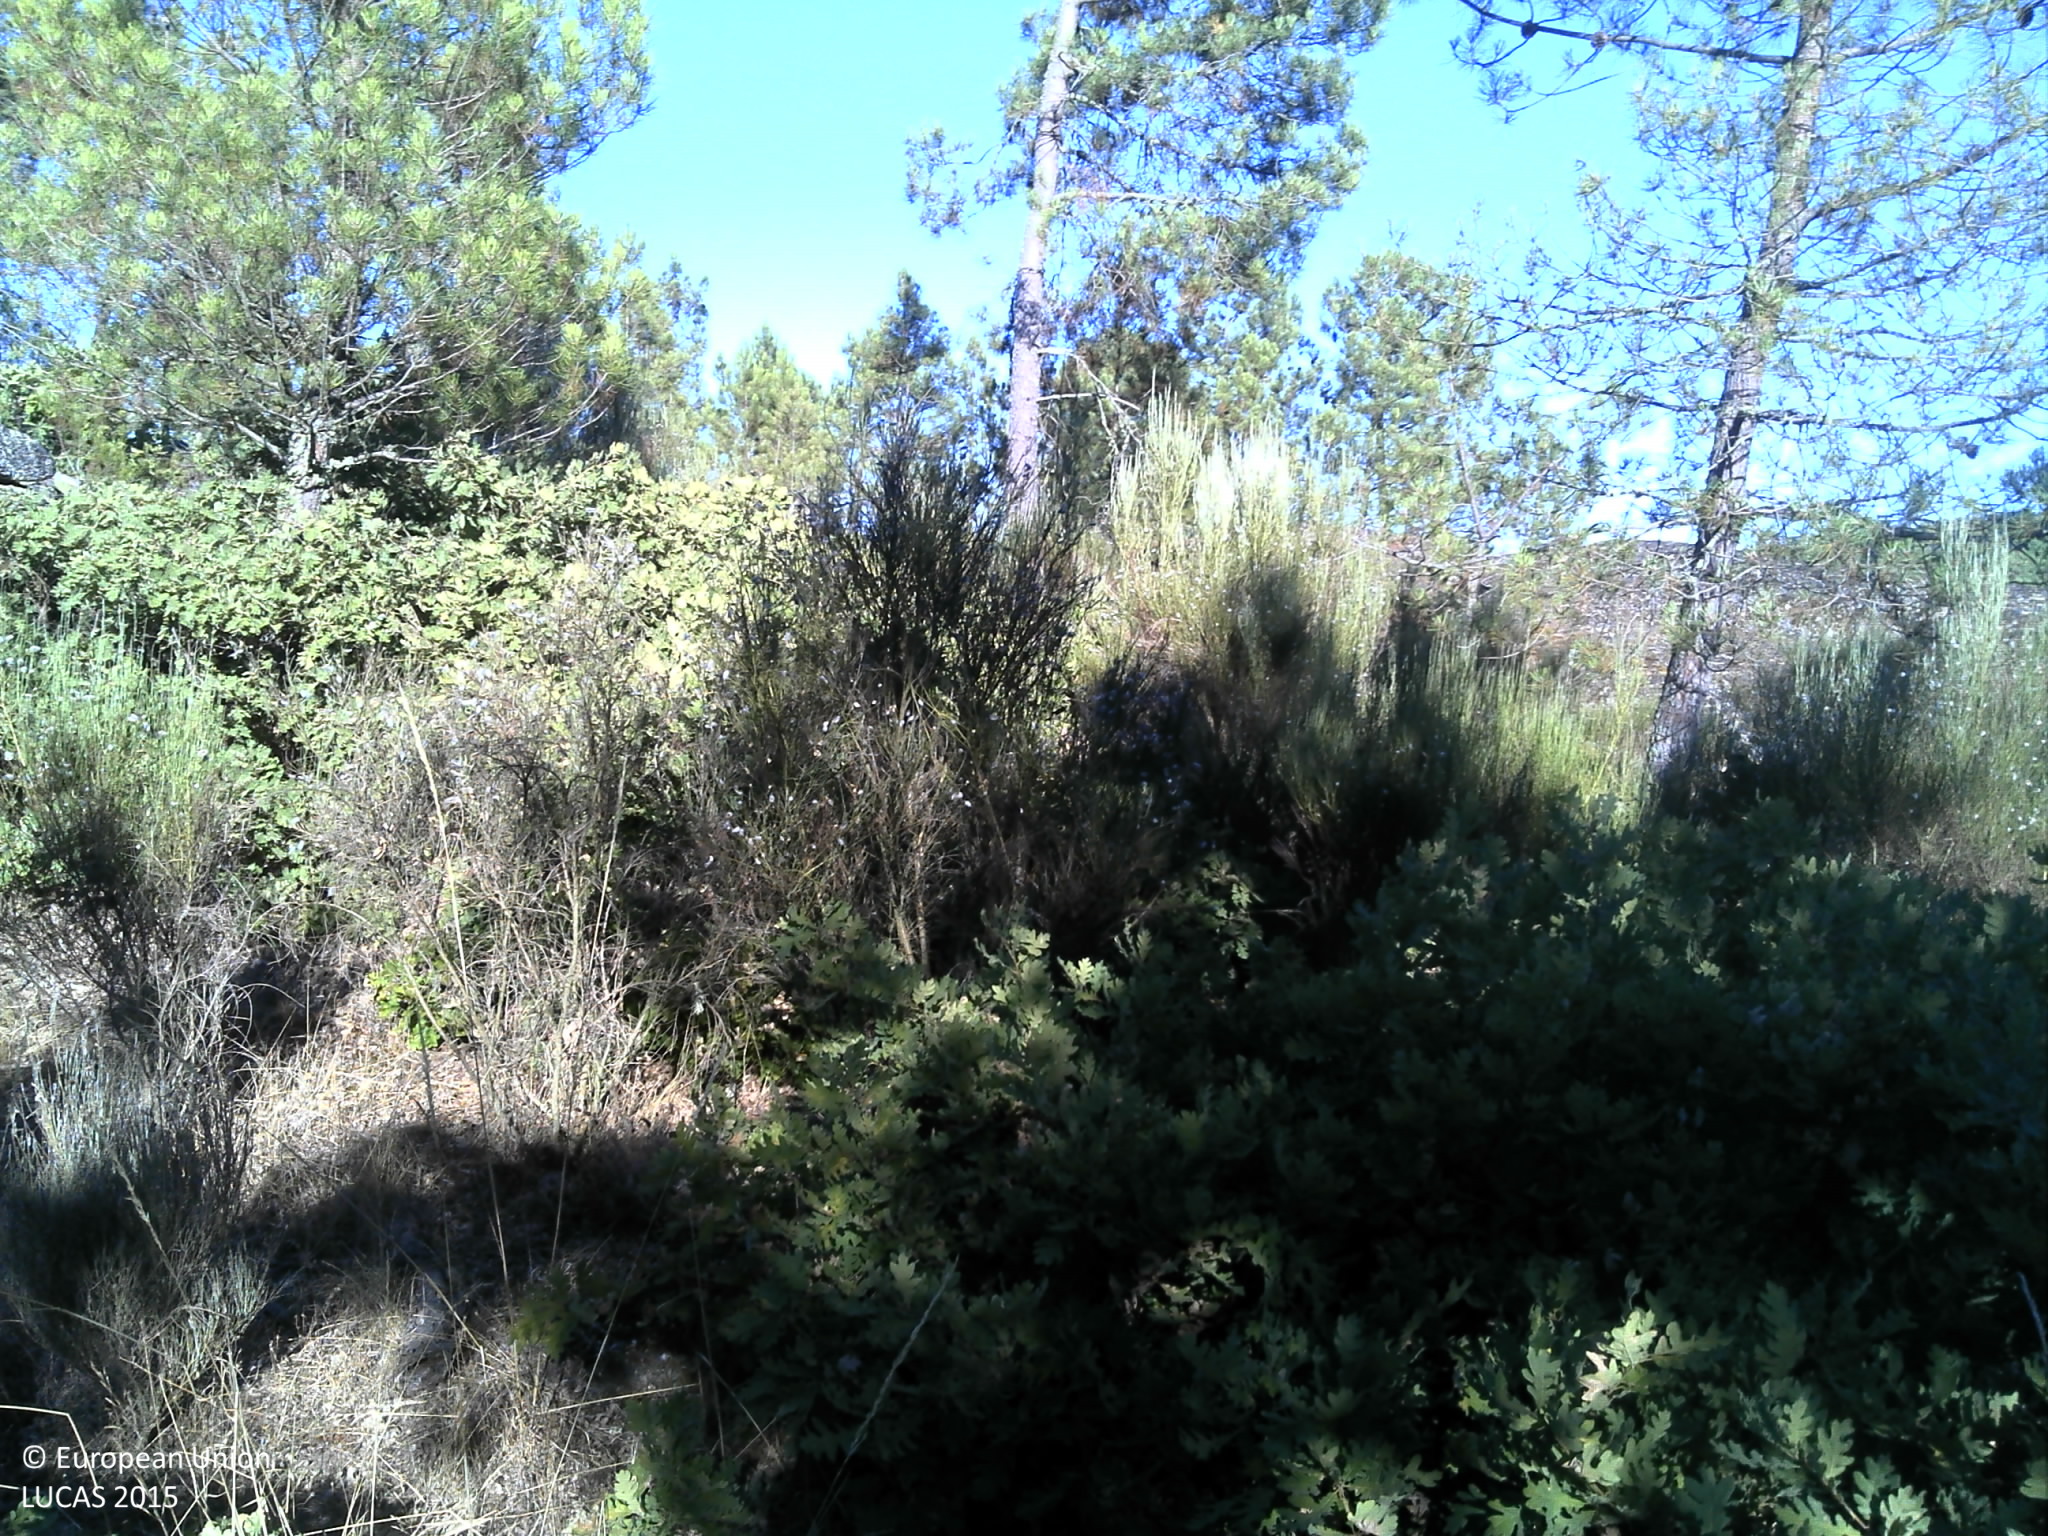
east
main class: Woodland
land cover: Broadleaved woodland
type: thermophilous deciduous forest
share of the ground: 10 - 25 %
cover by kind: consolidated bare surface 45 %, broadleaved forest trees 20 %, shrubs 20 %, herbaceous plants 10 %, unconsolidated bare surface 5 %
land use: Semi-natural and natural areas not in use
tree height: > 5 m
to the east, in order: Broadleaved woodland; Rocks and stones; Pine dominated coniferous woodland; Shrubland with sparse tree cover; Electric lines; Shrubland with sparse tree cover; Rocks and stones; Grassland without tree/shrub cover; Shrubland with sparse tree cover; Pine dominated coniferous woodland
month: July
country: PT
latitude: 41.3749
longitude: -7.4980
